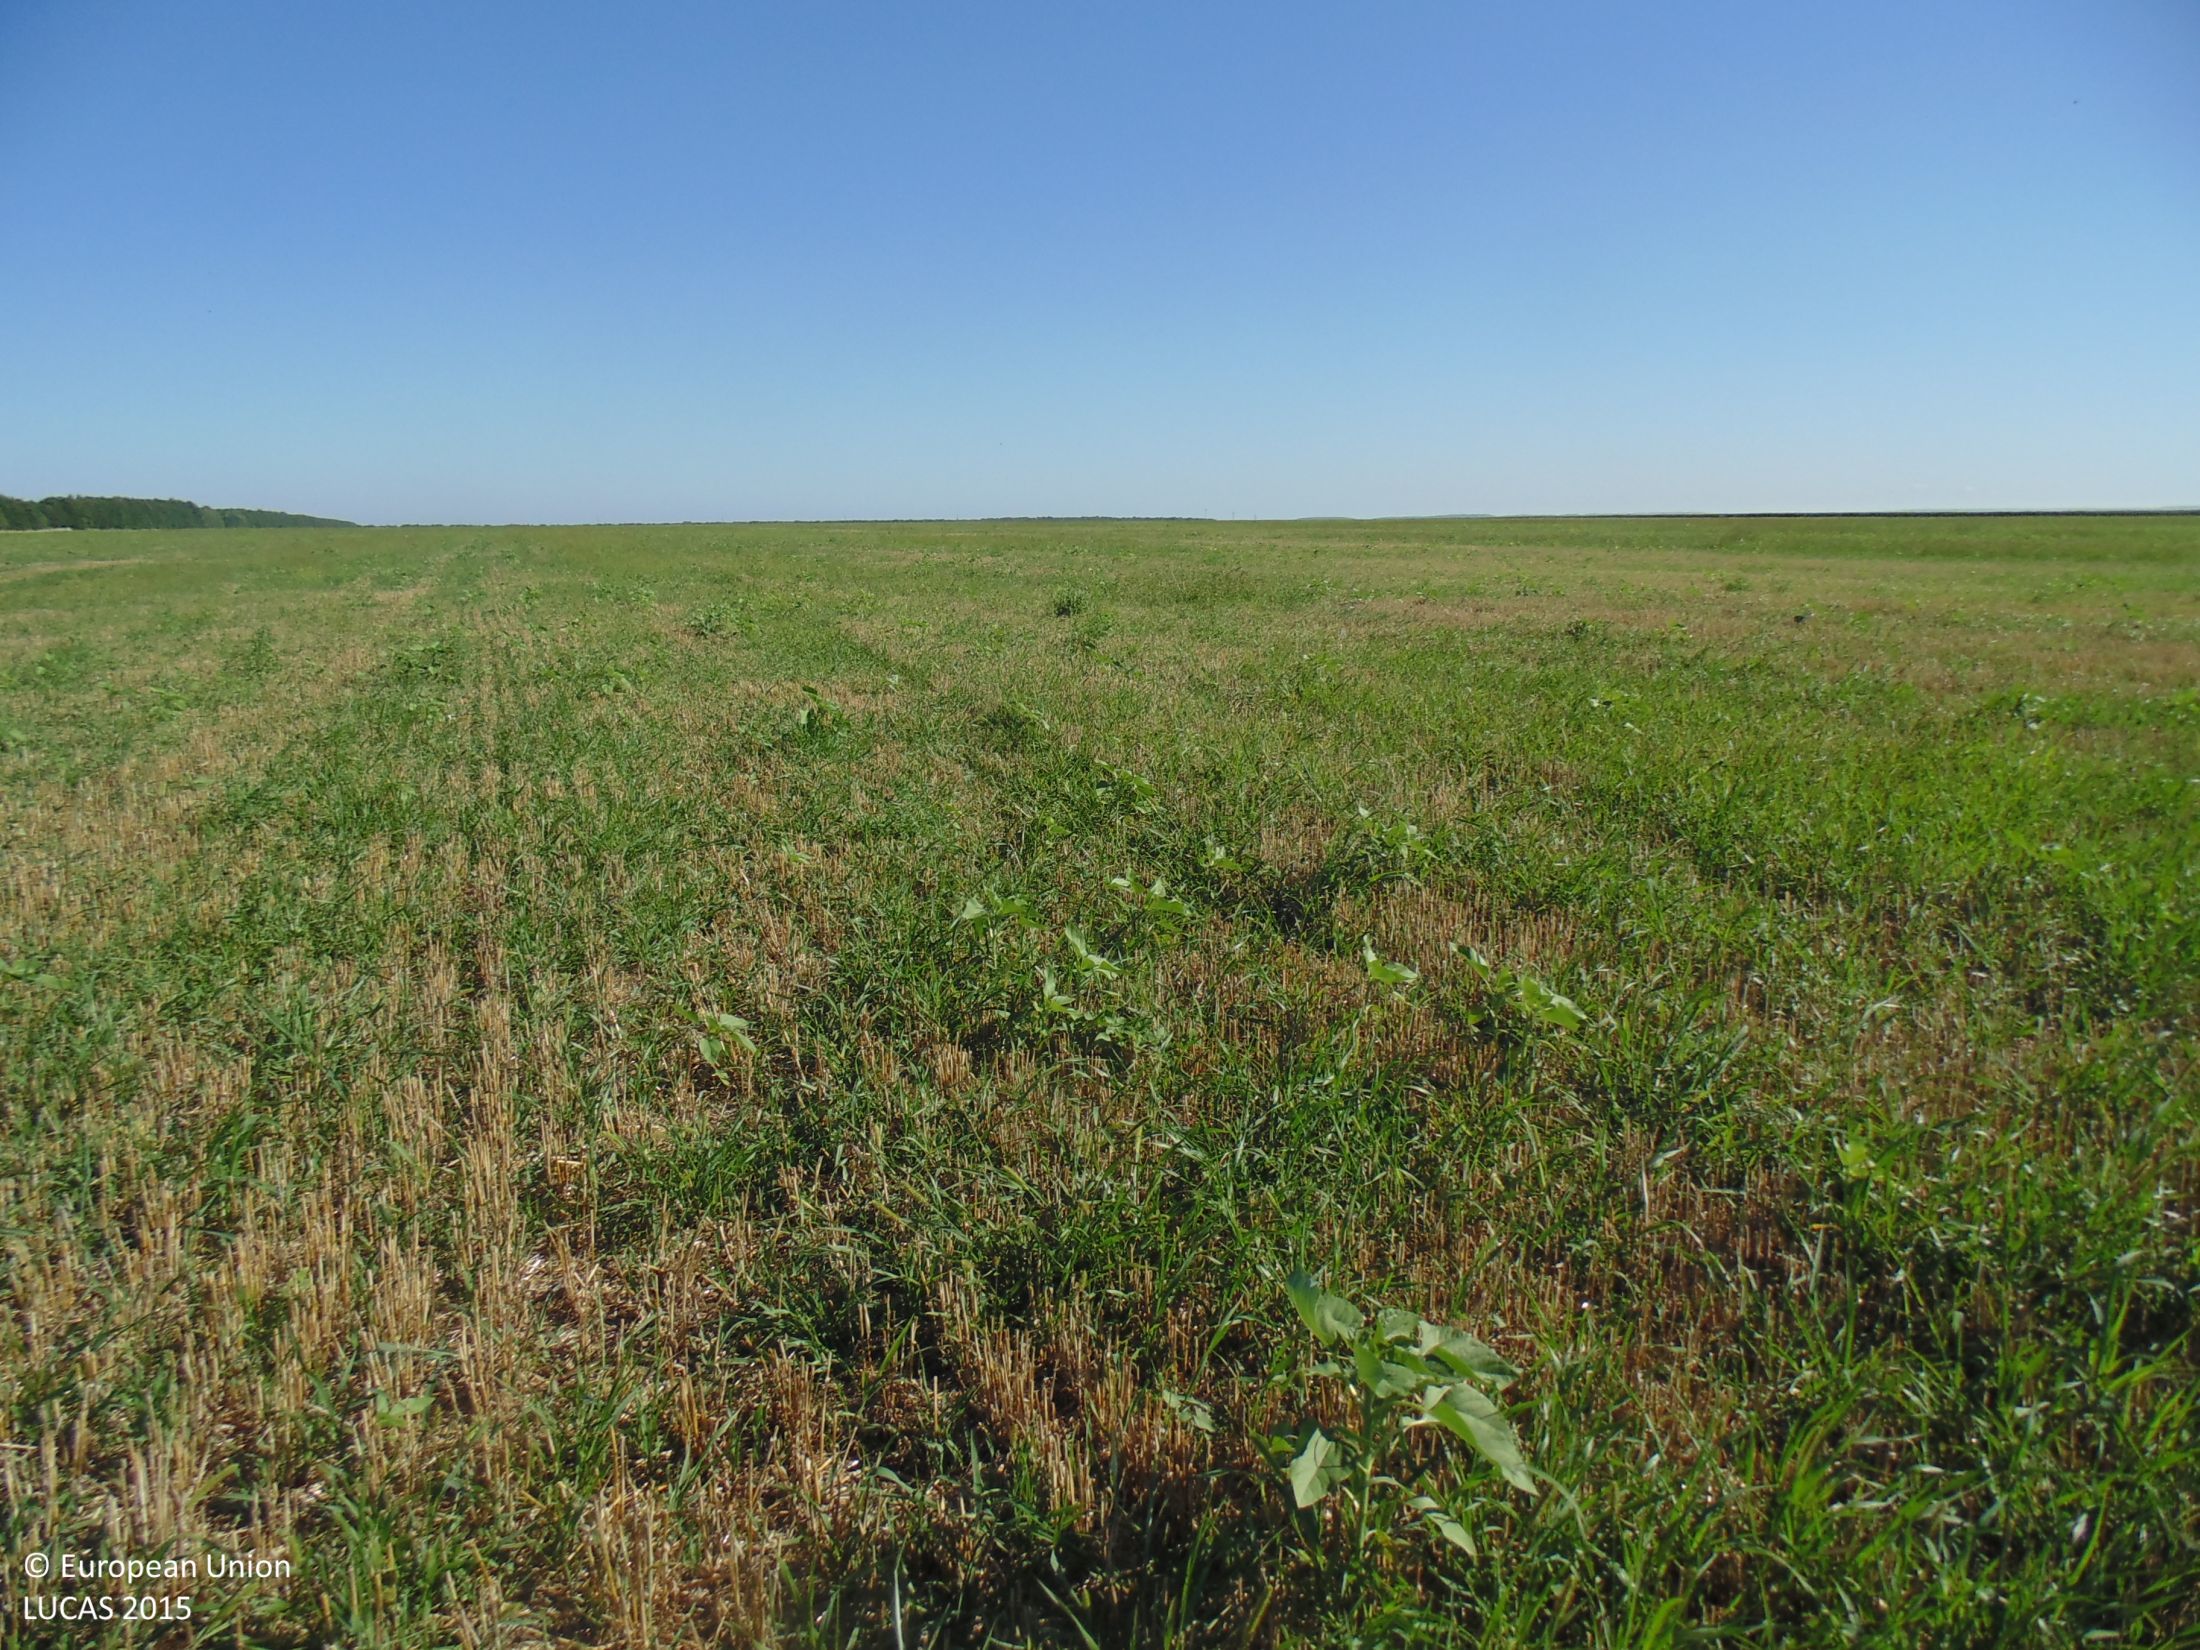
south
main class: Cropland
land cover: Barley
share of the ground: 10 - 25 %
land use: Agriculture (excluding fallow land and kitchen gardens)
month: July
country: BG
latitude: 43.4303
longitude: 28.0714
